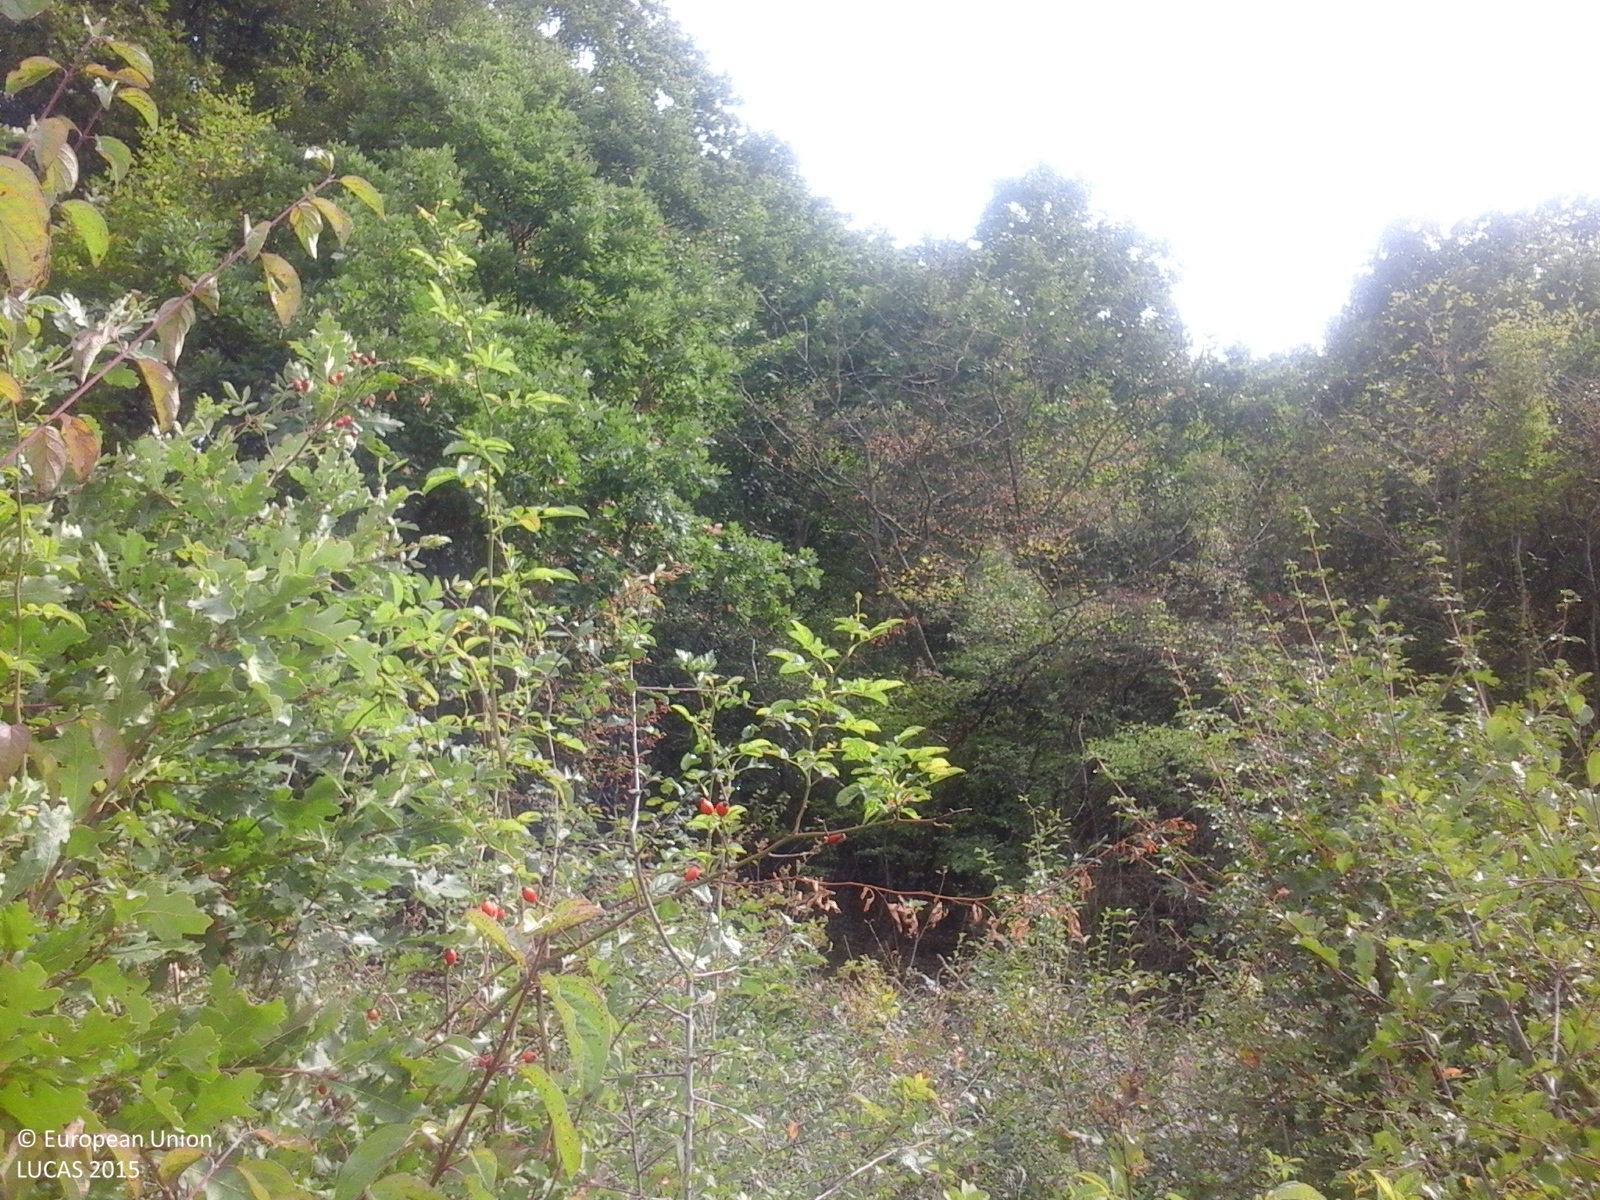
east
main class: Shrubland
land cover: Shrubland with sparse tree cover
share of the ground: > 75 %
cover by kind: shrubs 95 %, broadleaved forest trees 5 %
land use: Forestry
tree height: < 5 m
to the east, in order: Shrubland with sparse tree cover; Broadleaved woodland; Tracks; Broadleaved woodland; Tracks; Broadleaved woodland
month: September
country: RO
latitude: 47.1832
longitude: 23.6805
